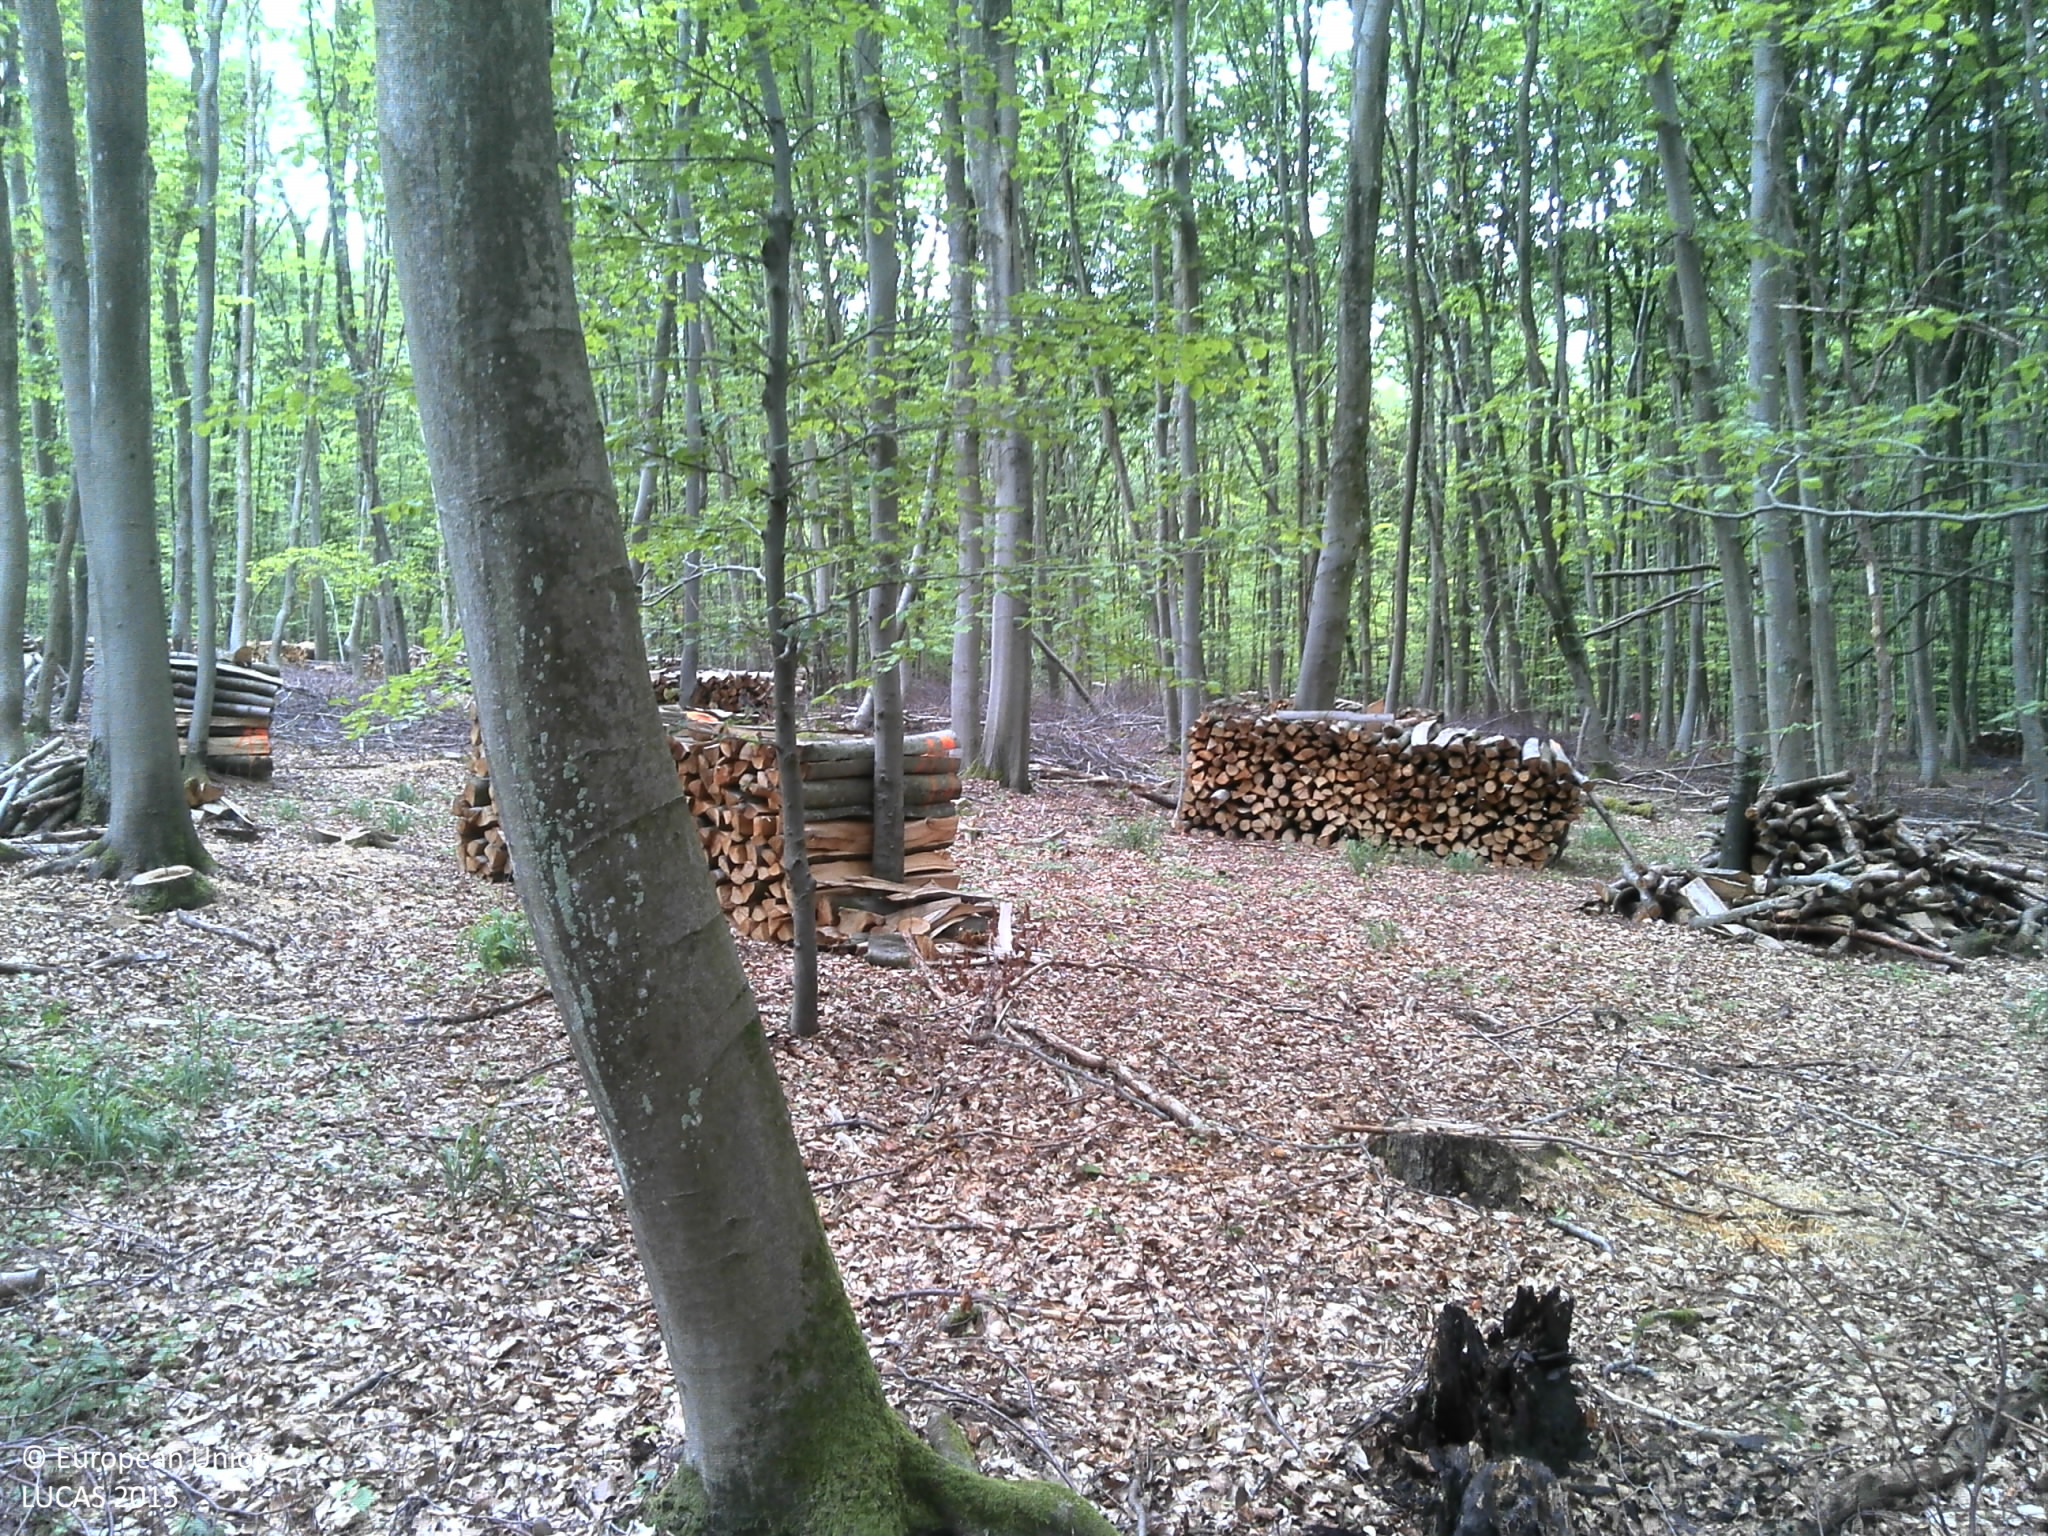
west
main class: Woodland
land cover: Broadleaved woodland
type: beech forest
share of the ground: > 75 %
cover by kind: broadleaved forest trees 100 %
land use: Forestry
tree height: > 5 m
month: July
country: FR
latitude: 49.3741
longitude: 6.4879
